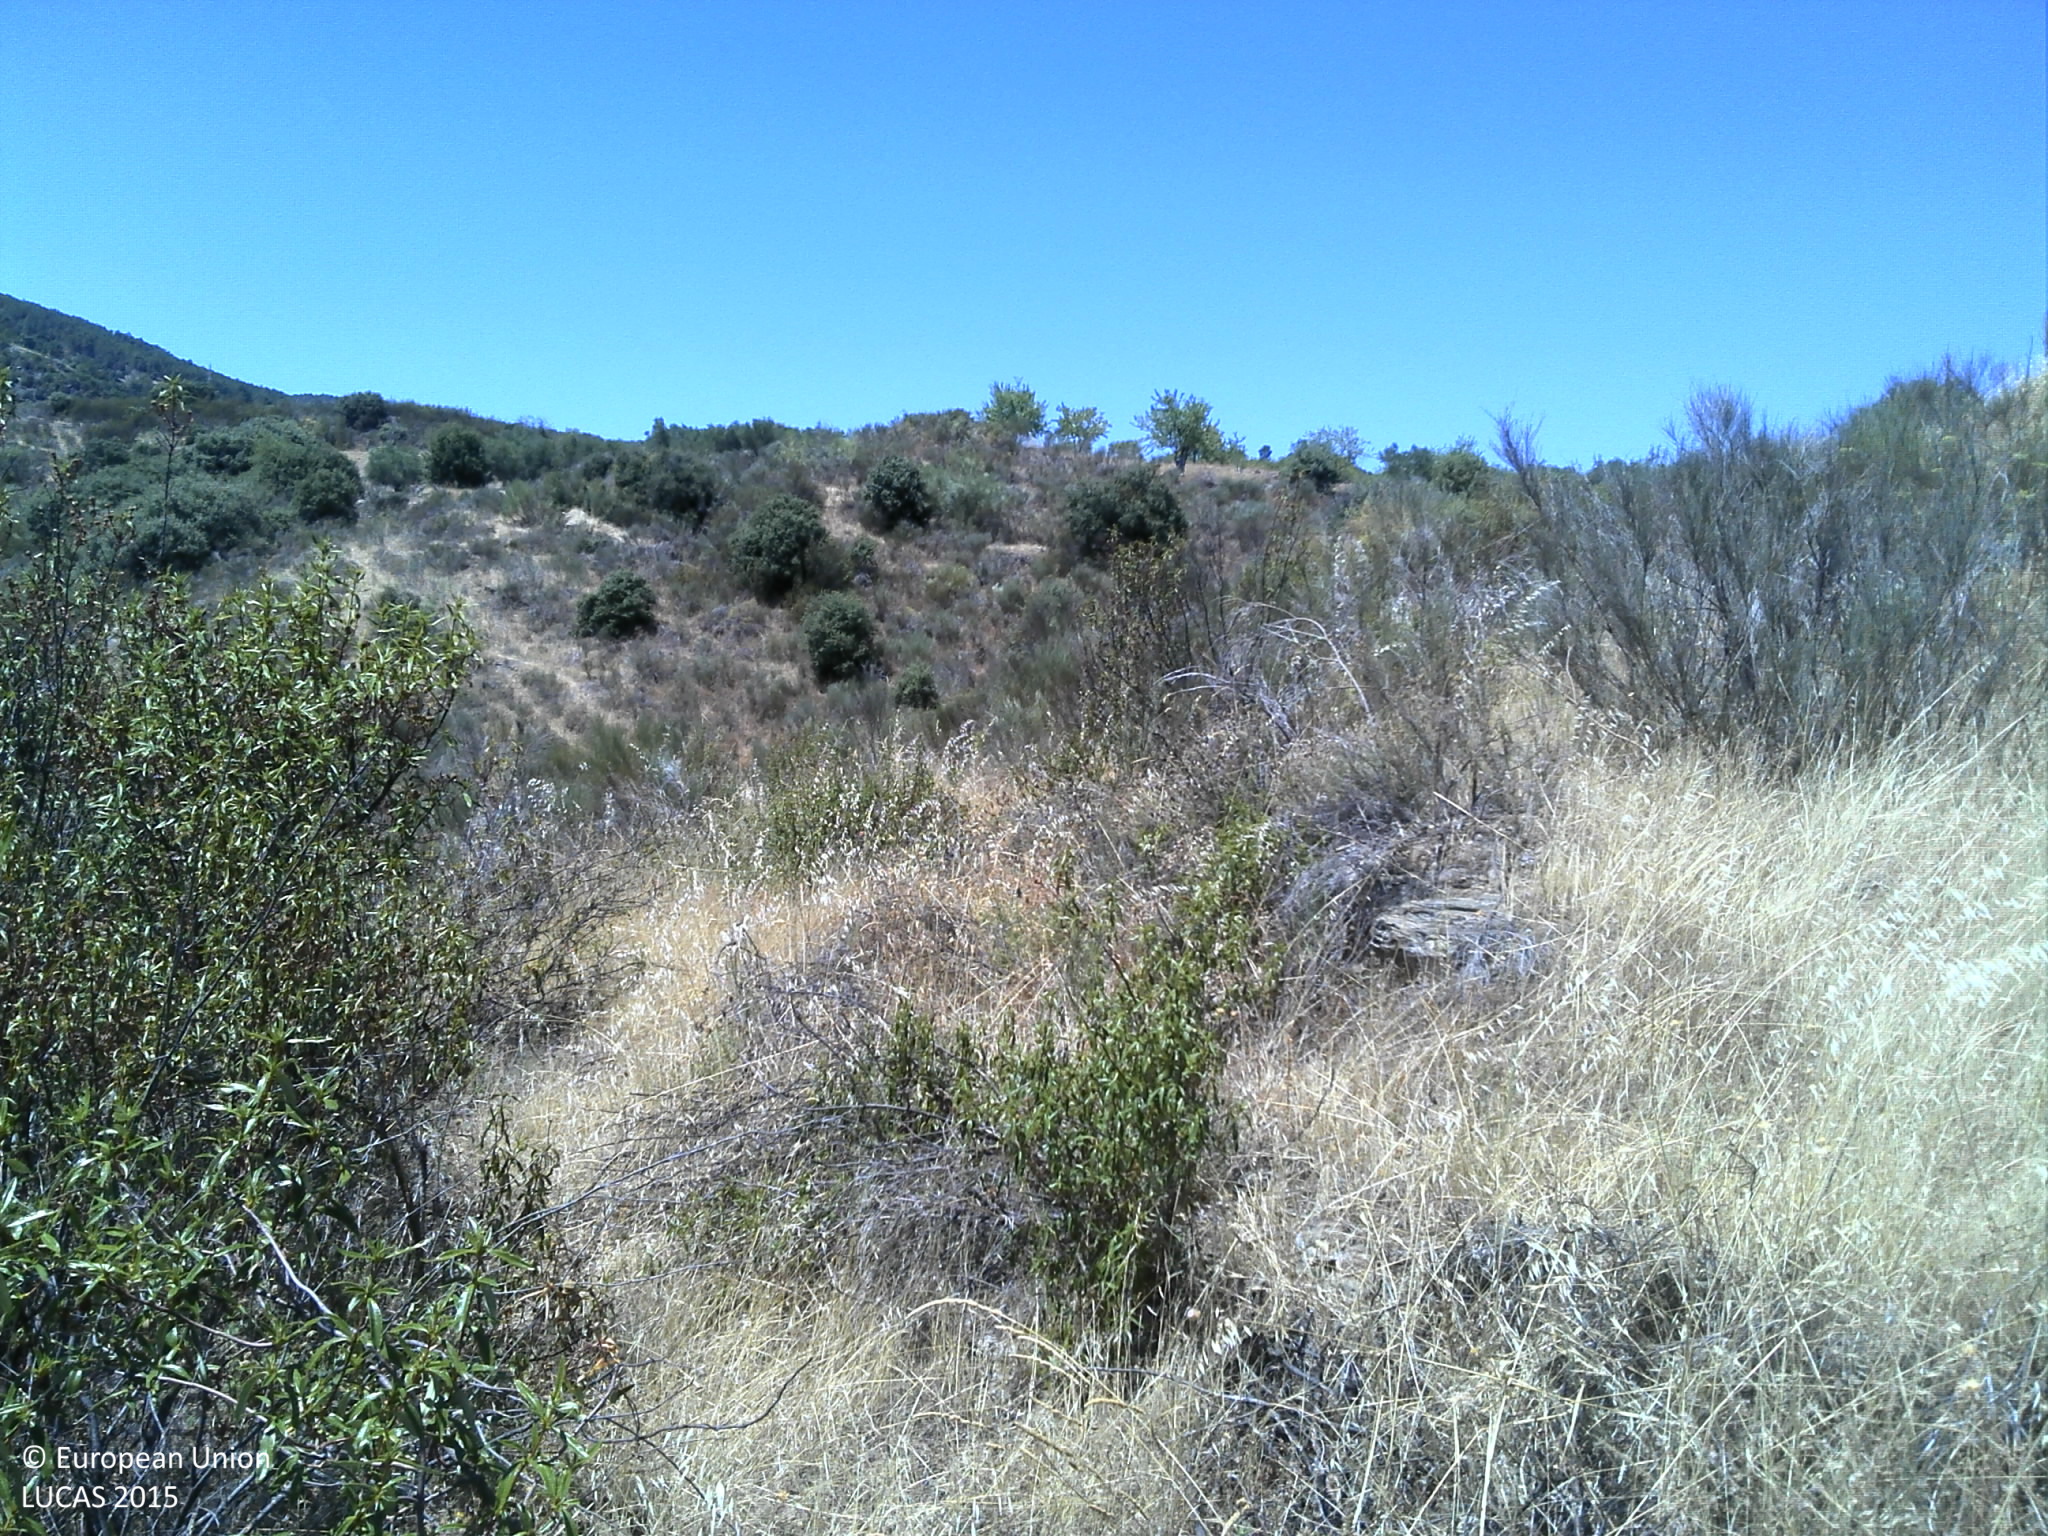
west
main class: Shrubland
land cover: Shrubland without tree cover
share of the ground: > 75 %
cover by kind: shrubs 80 %, herbaceous plants 20 %
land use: Abandoned areas
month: July
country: PT
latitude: 41.3138
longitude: -7.1127
